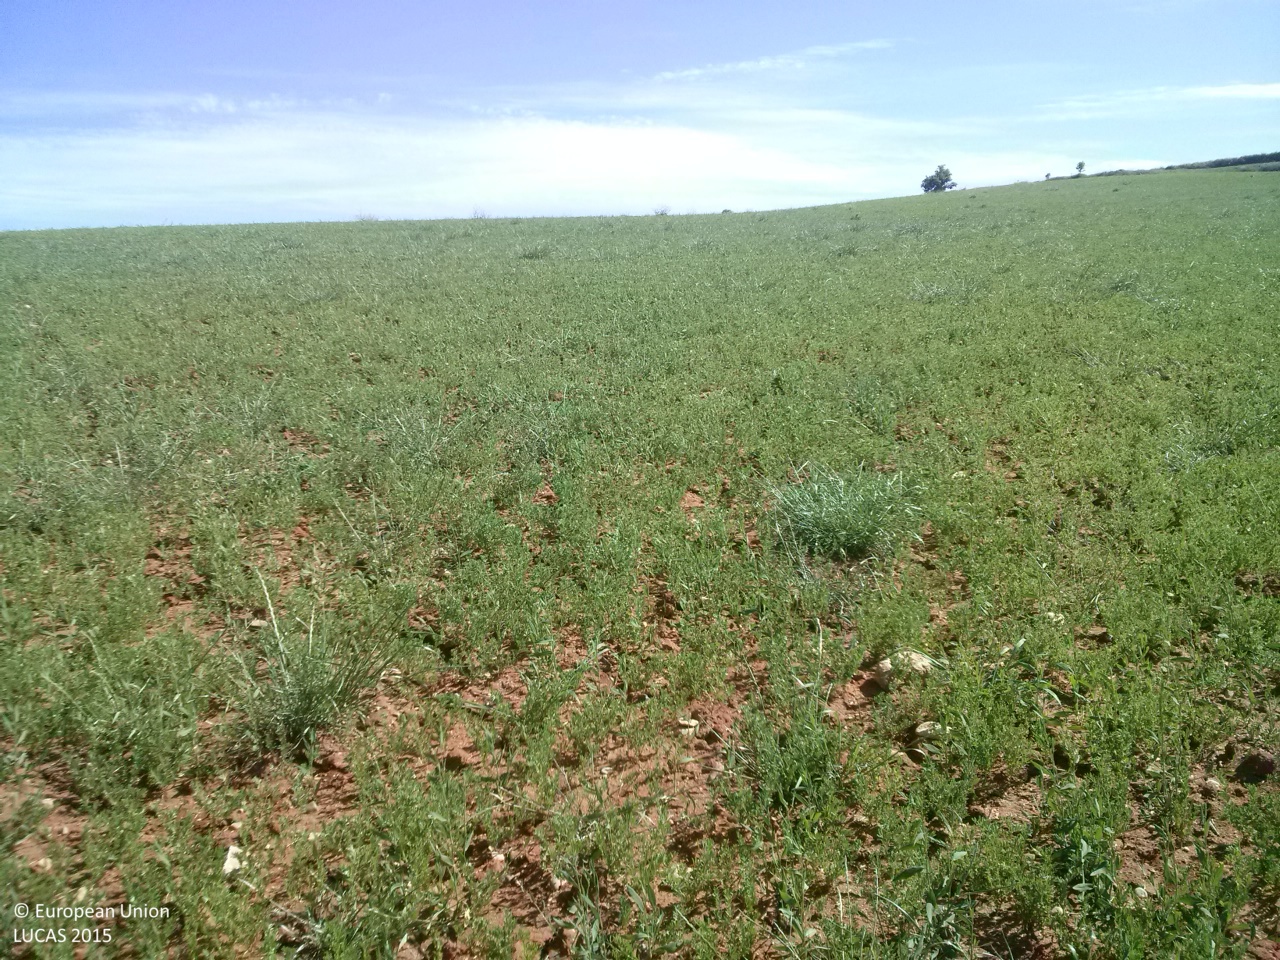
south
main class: Cropland
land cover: Dry pulses
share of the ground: 50 - 75 %
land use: Agriculture (excluding fallow land and kitchen gardens)
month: May
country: ES
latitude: 39.8202
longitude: -2.7174
